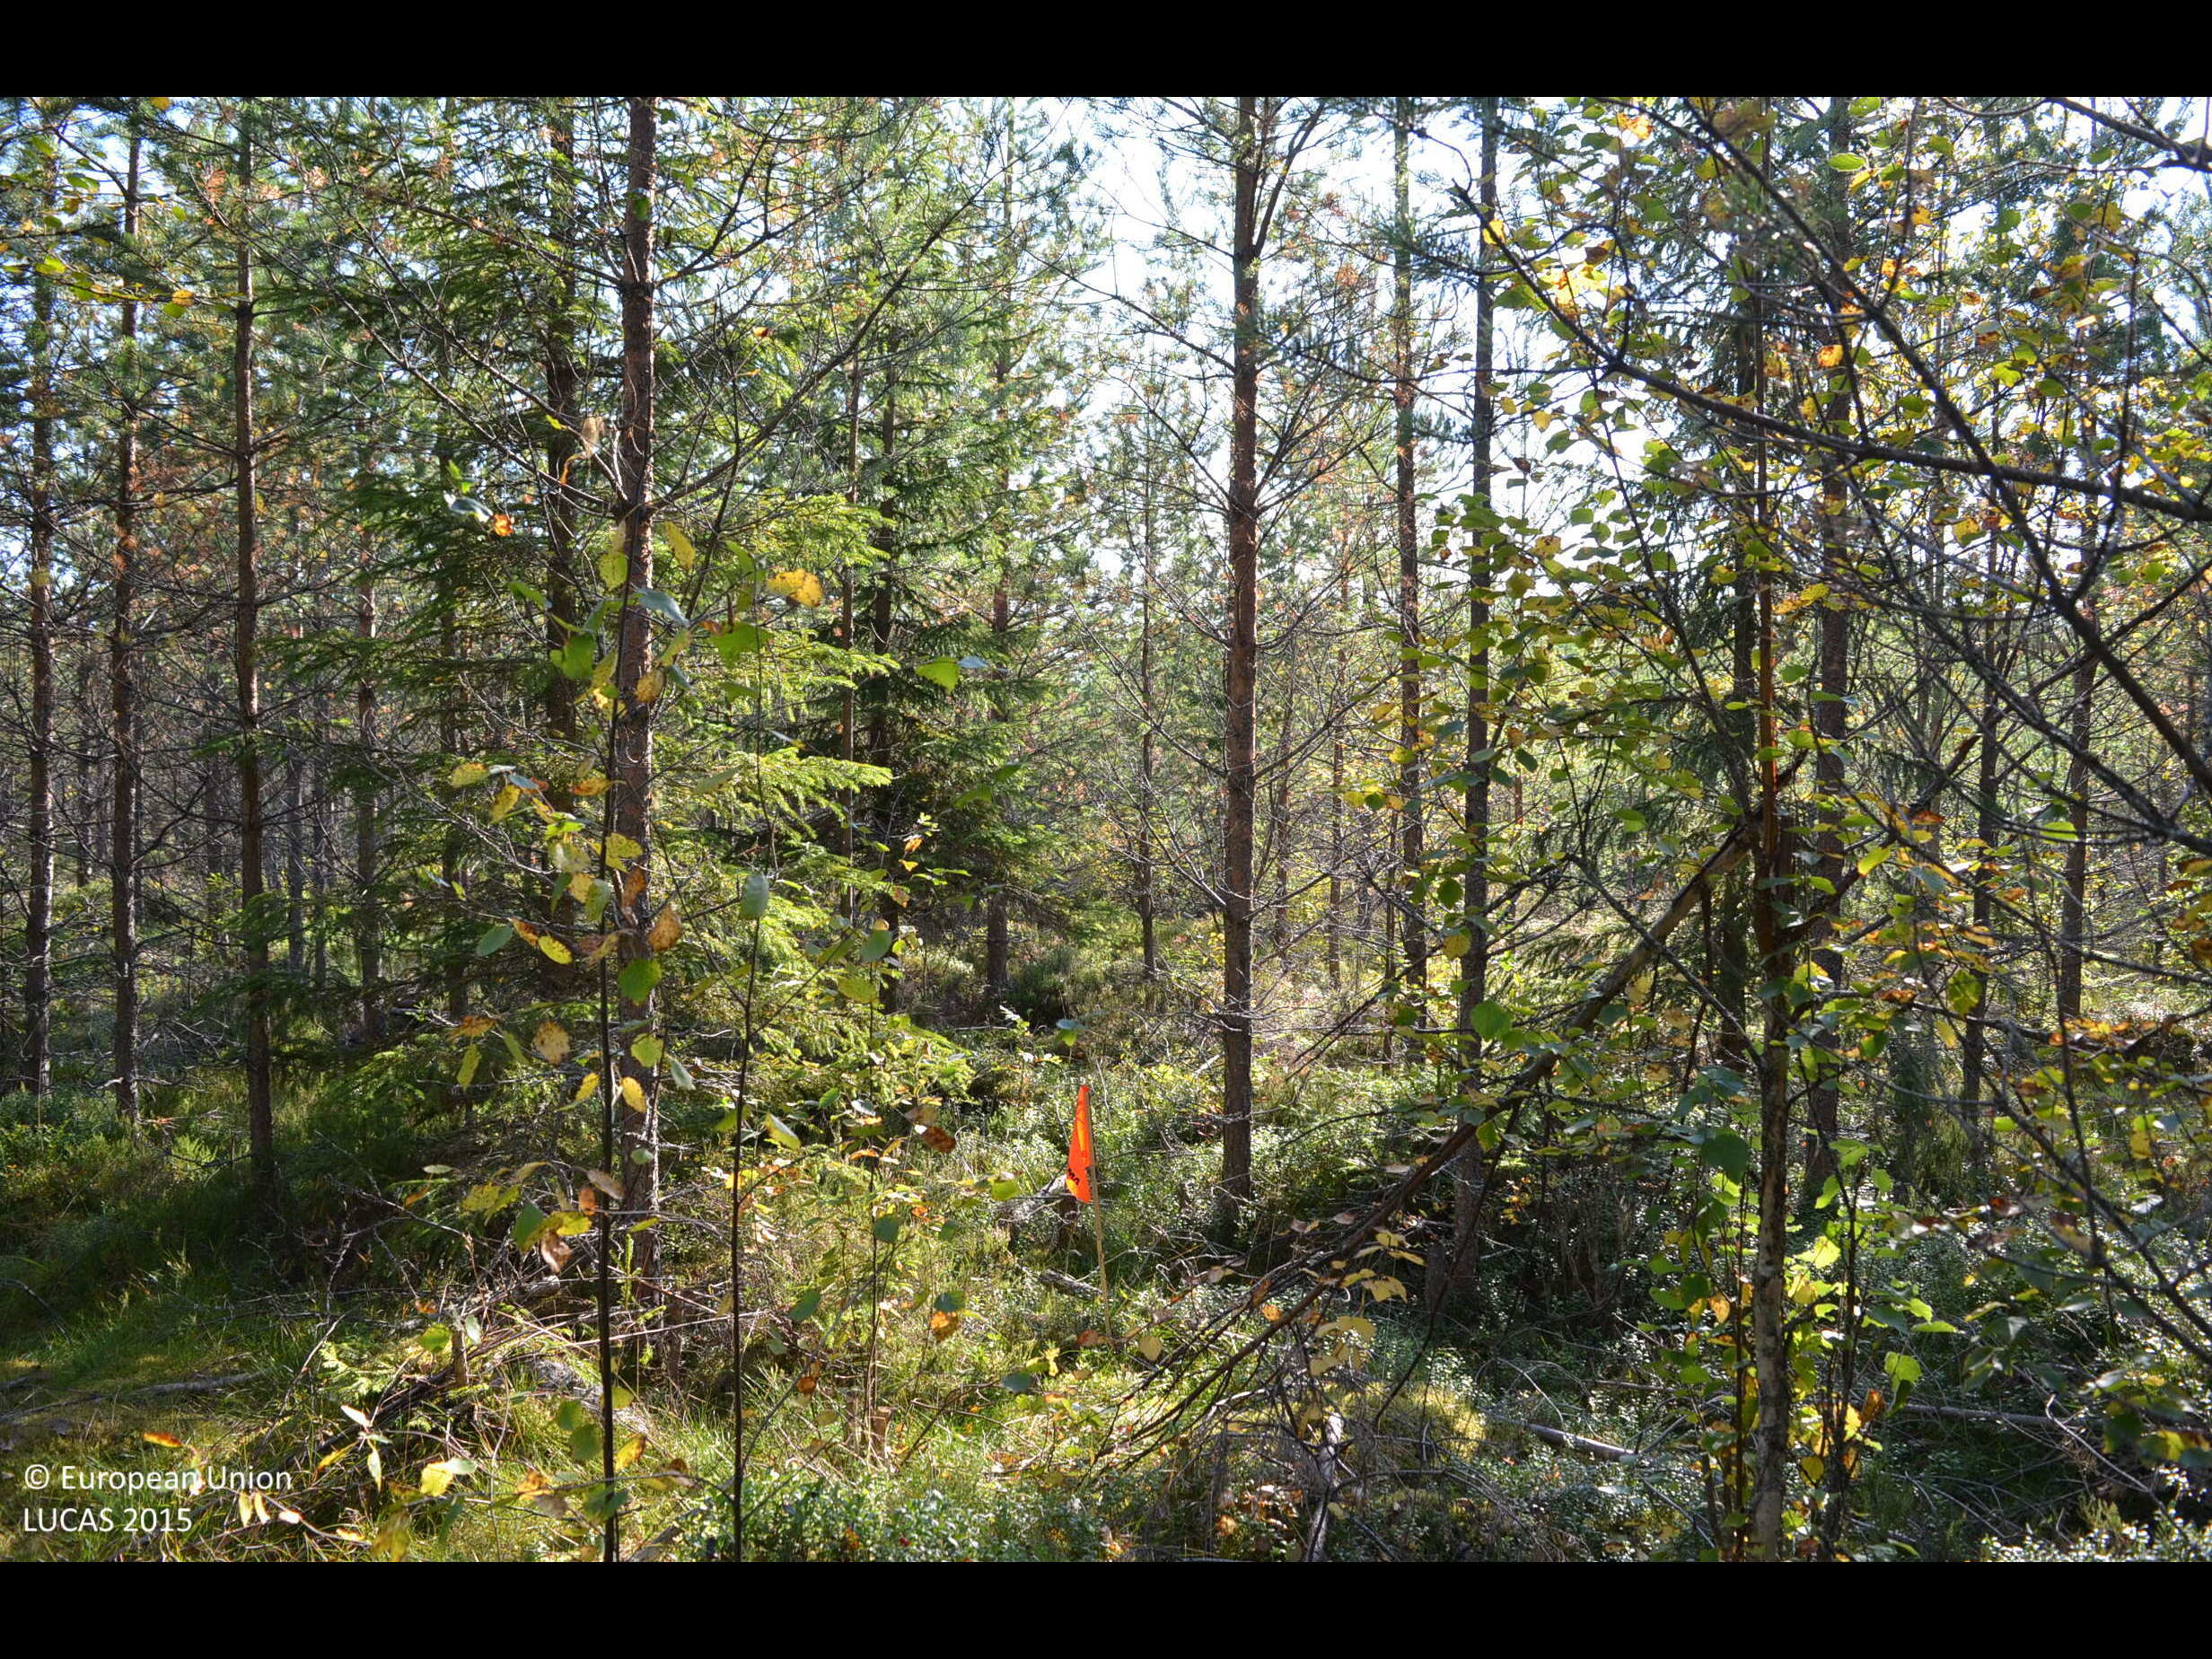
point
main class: Woodland
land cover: Other mixed woodland
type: boreal forest
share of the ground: > 75 %
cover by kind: coniferous forest trees 55 %, broadleaved forest trees 20 %, shrubs 20 %, lichens and mosses 5 %
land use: Forestry
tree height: > 5 m
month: September
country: FI
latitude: 62.9367
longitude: 24.4868
